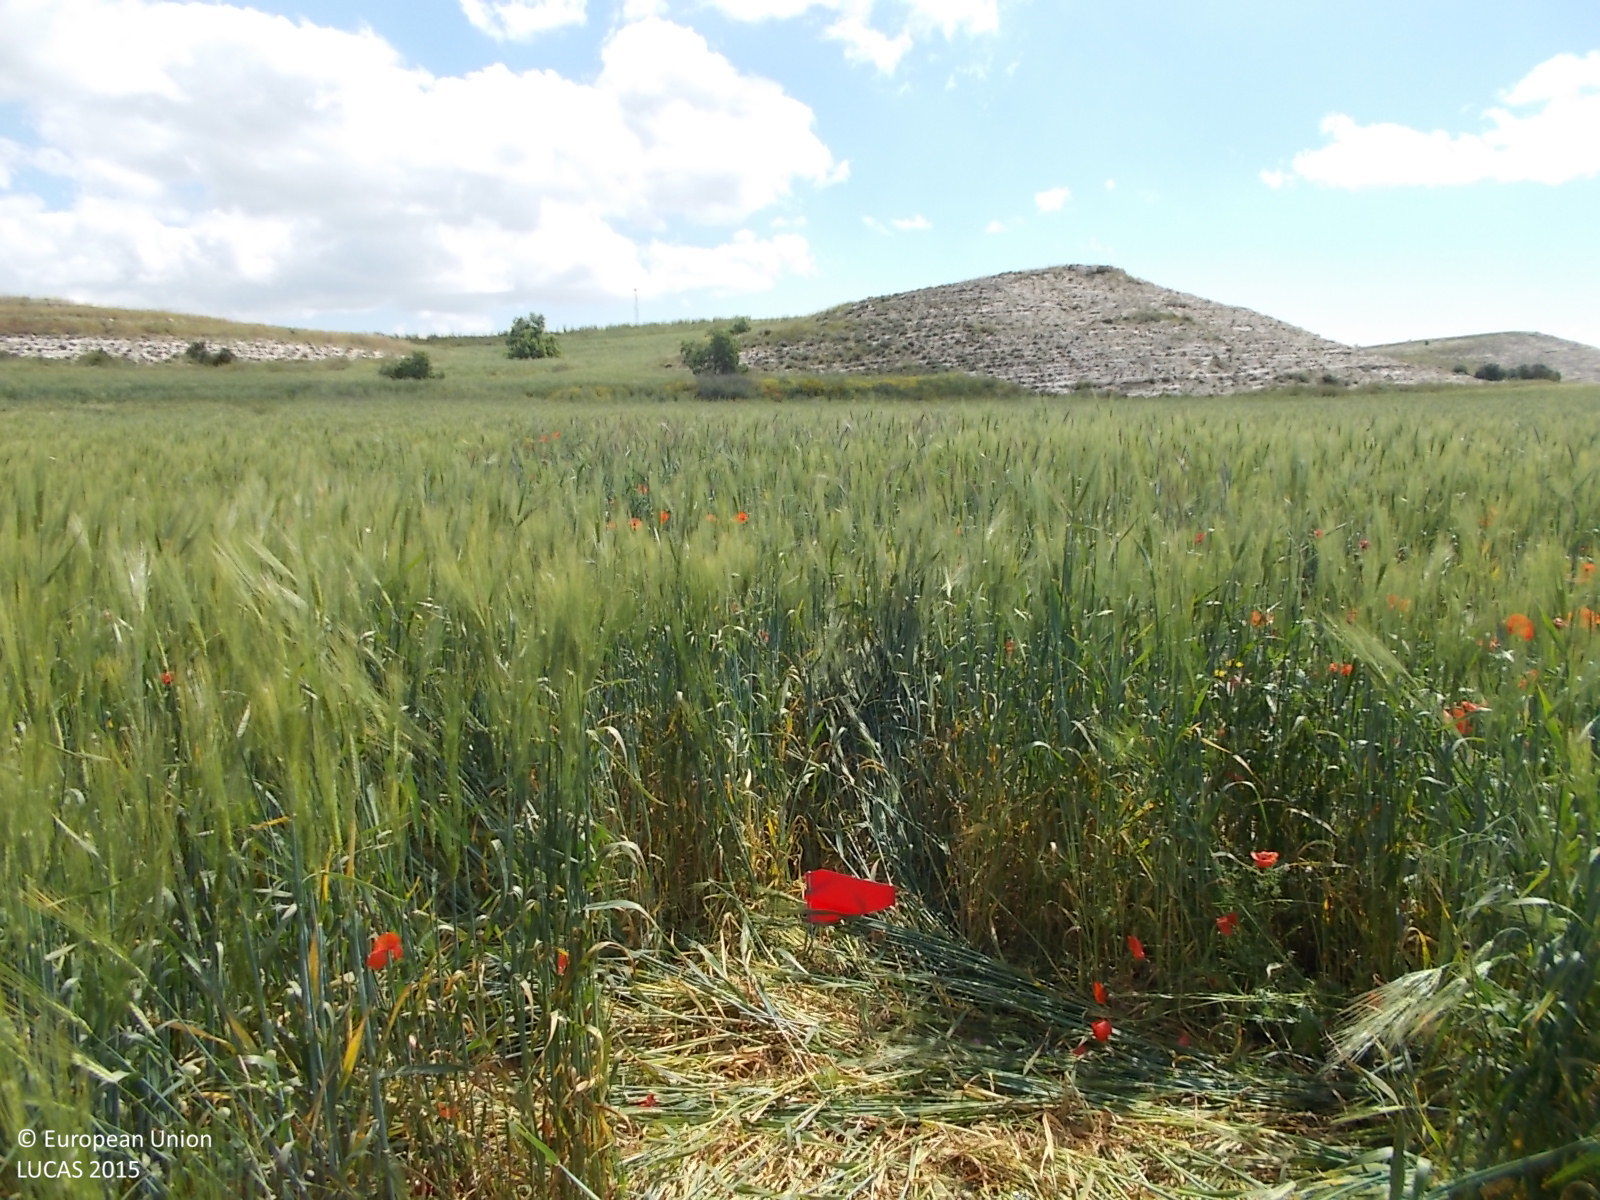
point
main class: Cropland
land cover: Barley
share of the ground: > 75 %
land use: Agriculture (excluding fallow land and kitchen gardens)
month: April
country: CY
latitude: 35.0372
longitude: 33.5112
